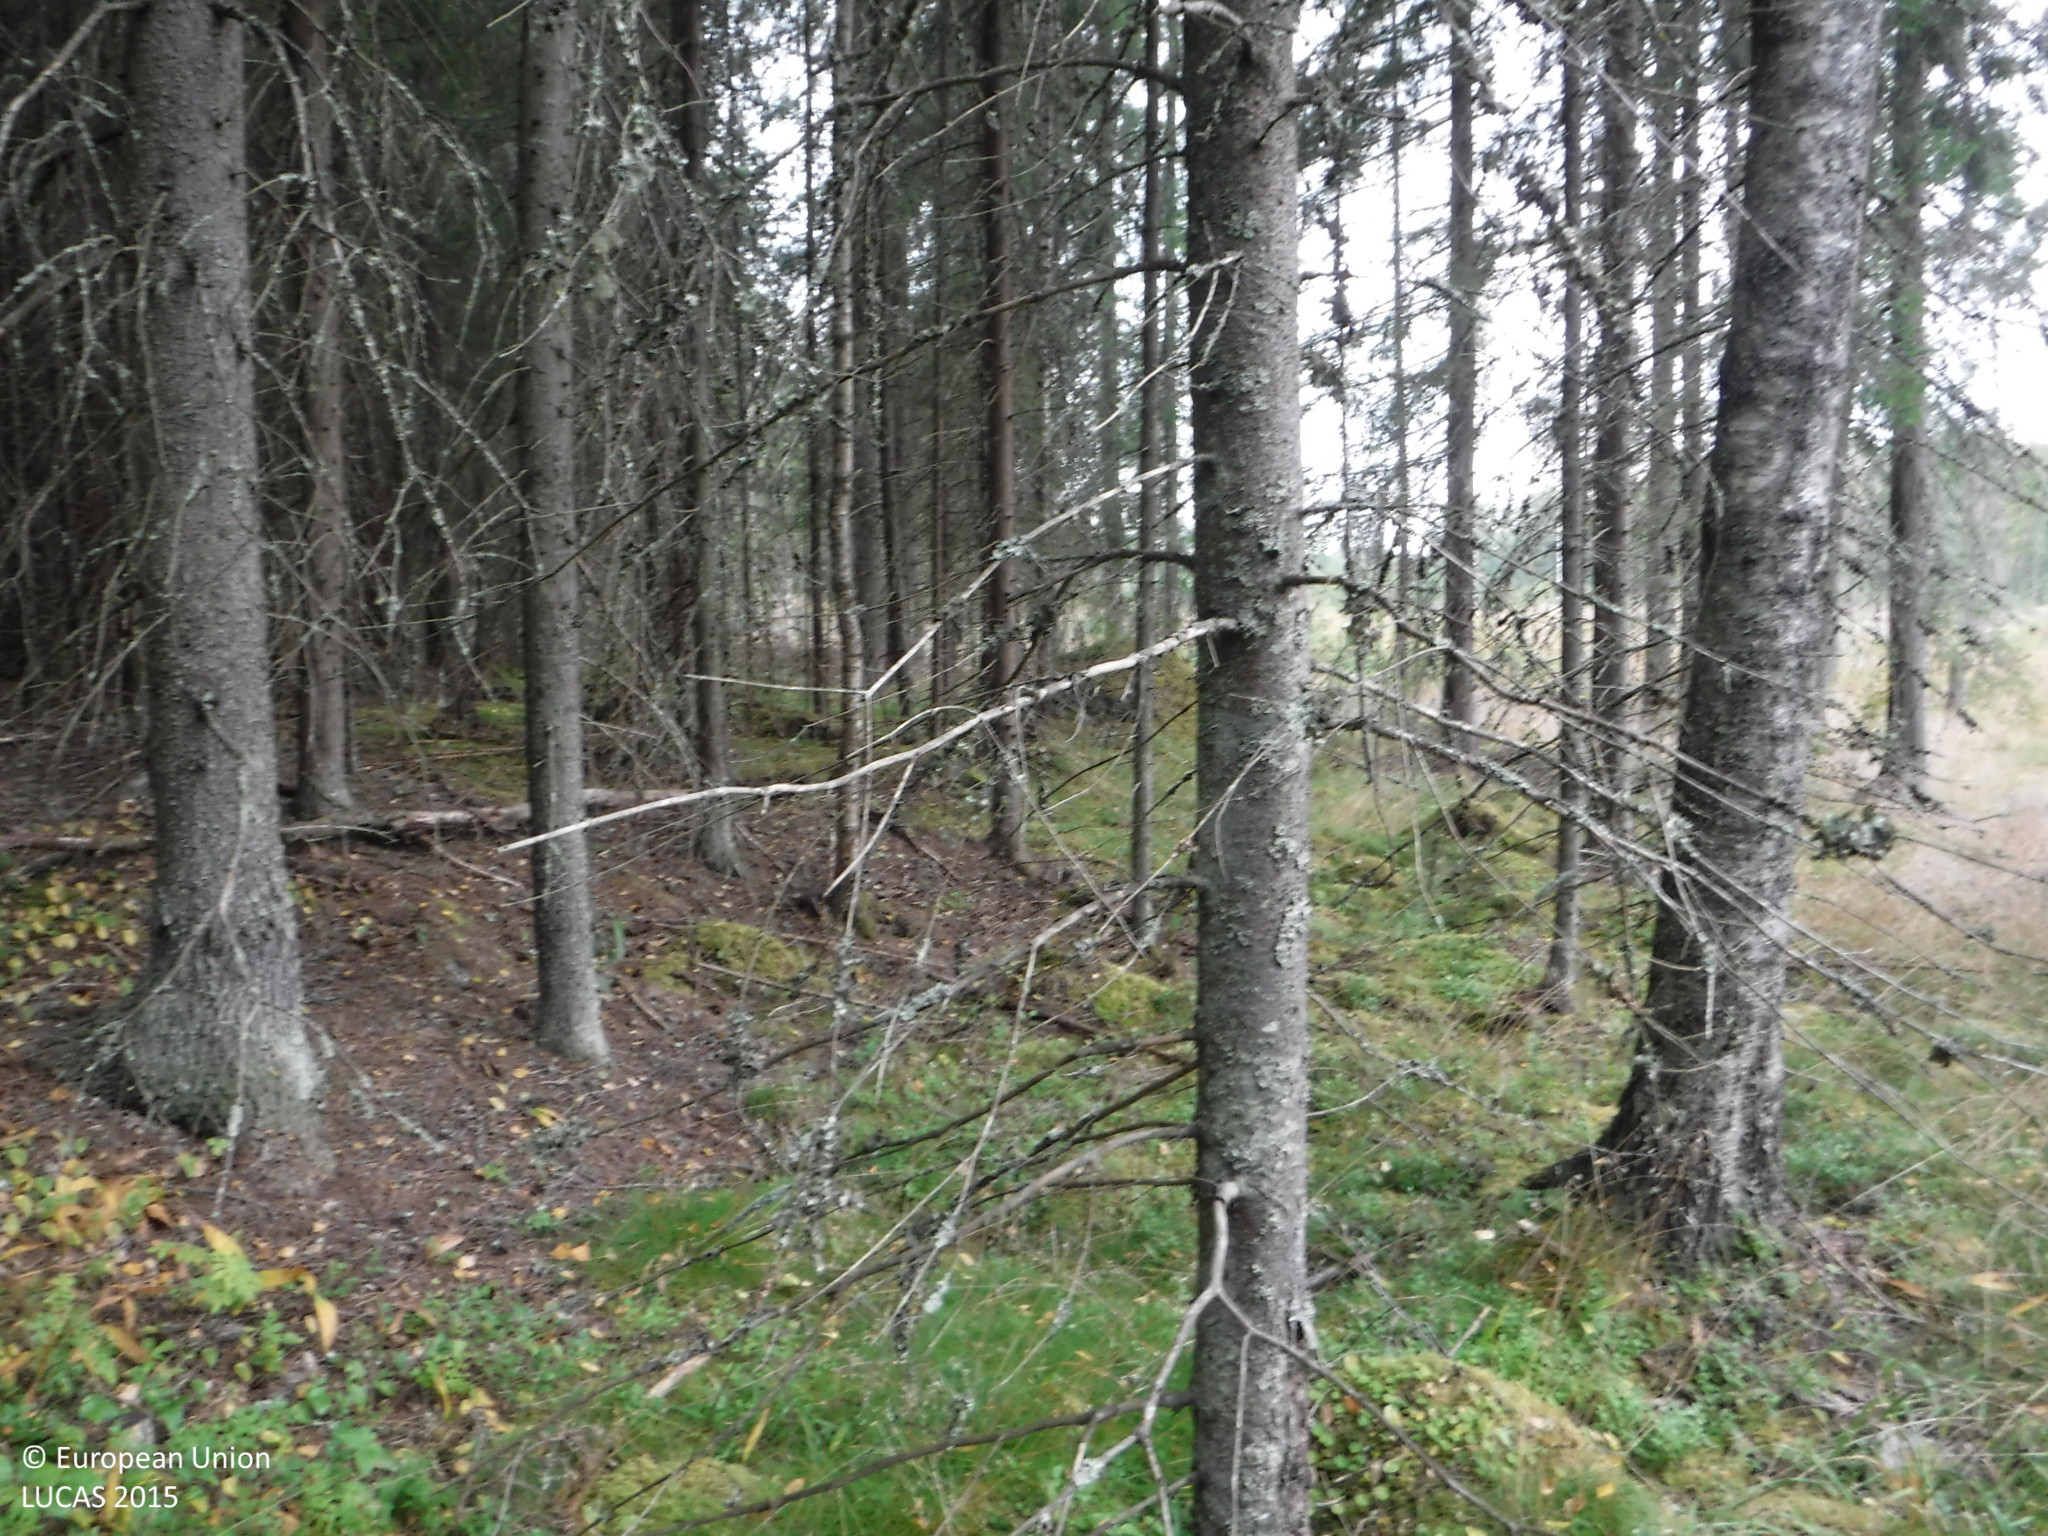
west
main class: Woodland
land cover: Spruce dominated coniferous woodland
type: boreal forest
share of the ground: > 75 %
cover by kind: coniferous forest trees 75 %, lichens and mosses 15 %, broadleaved forest trees 5 %, shrubs 5 %
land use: Forestry
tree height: > 5 m
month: August
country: FI
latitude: 61.2206
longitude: 23.0142
